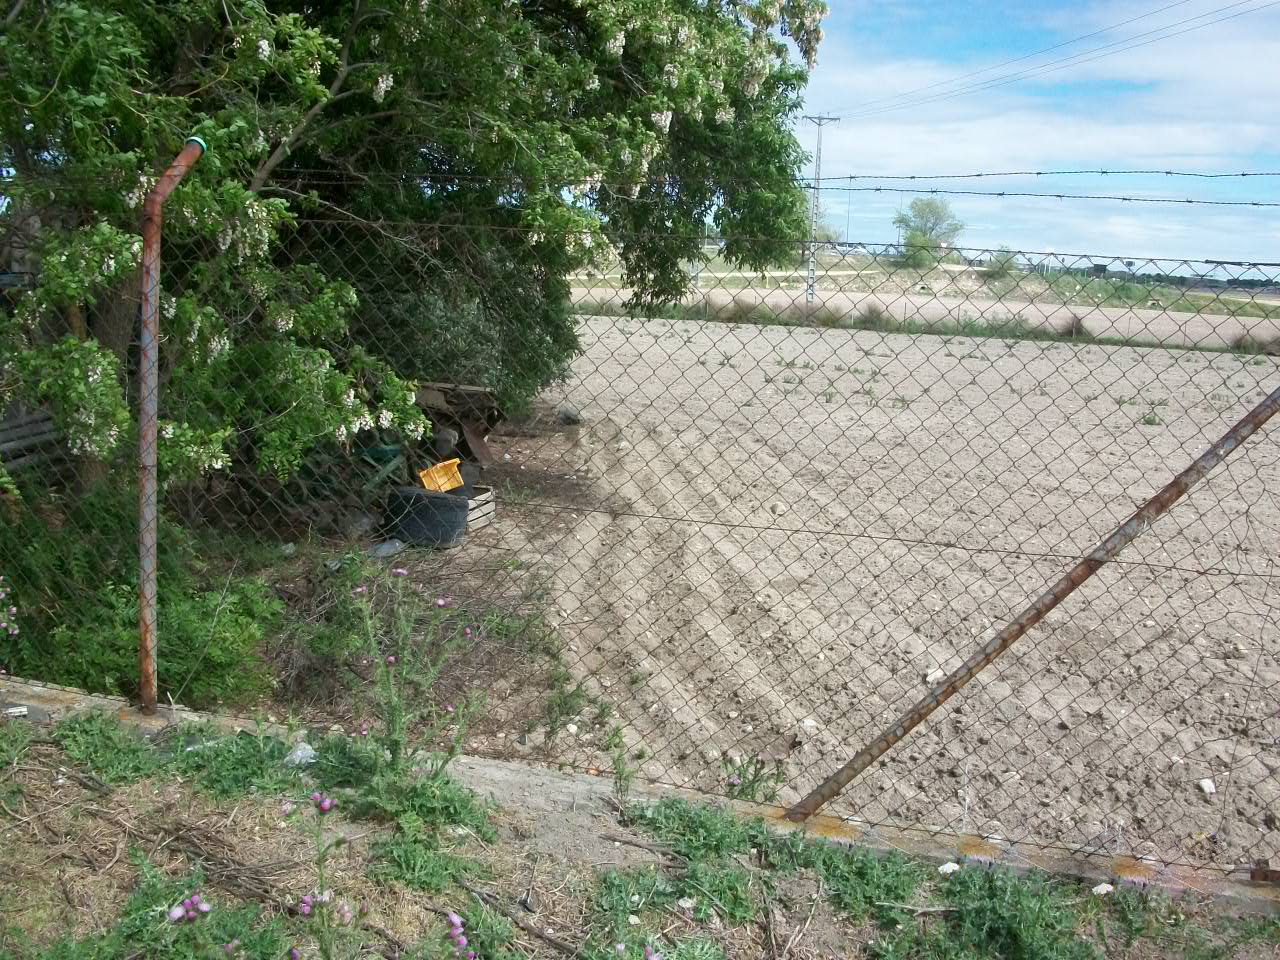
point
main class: Woodland
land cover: Broadleaved woodland
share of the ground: 50 - 75 %
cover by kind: broadleaved forest trees 60 %, herbaceous plants 40 %
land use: Residential
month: May
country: ES
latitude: 40.2349
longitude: -3.7047
